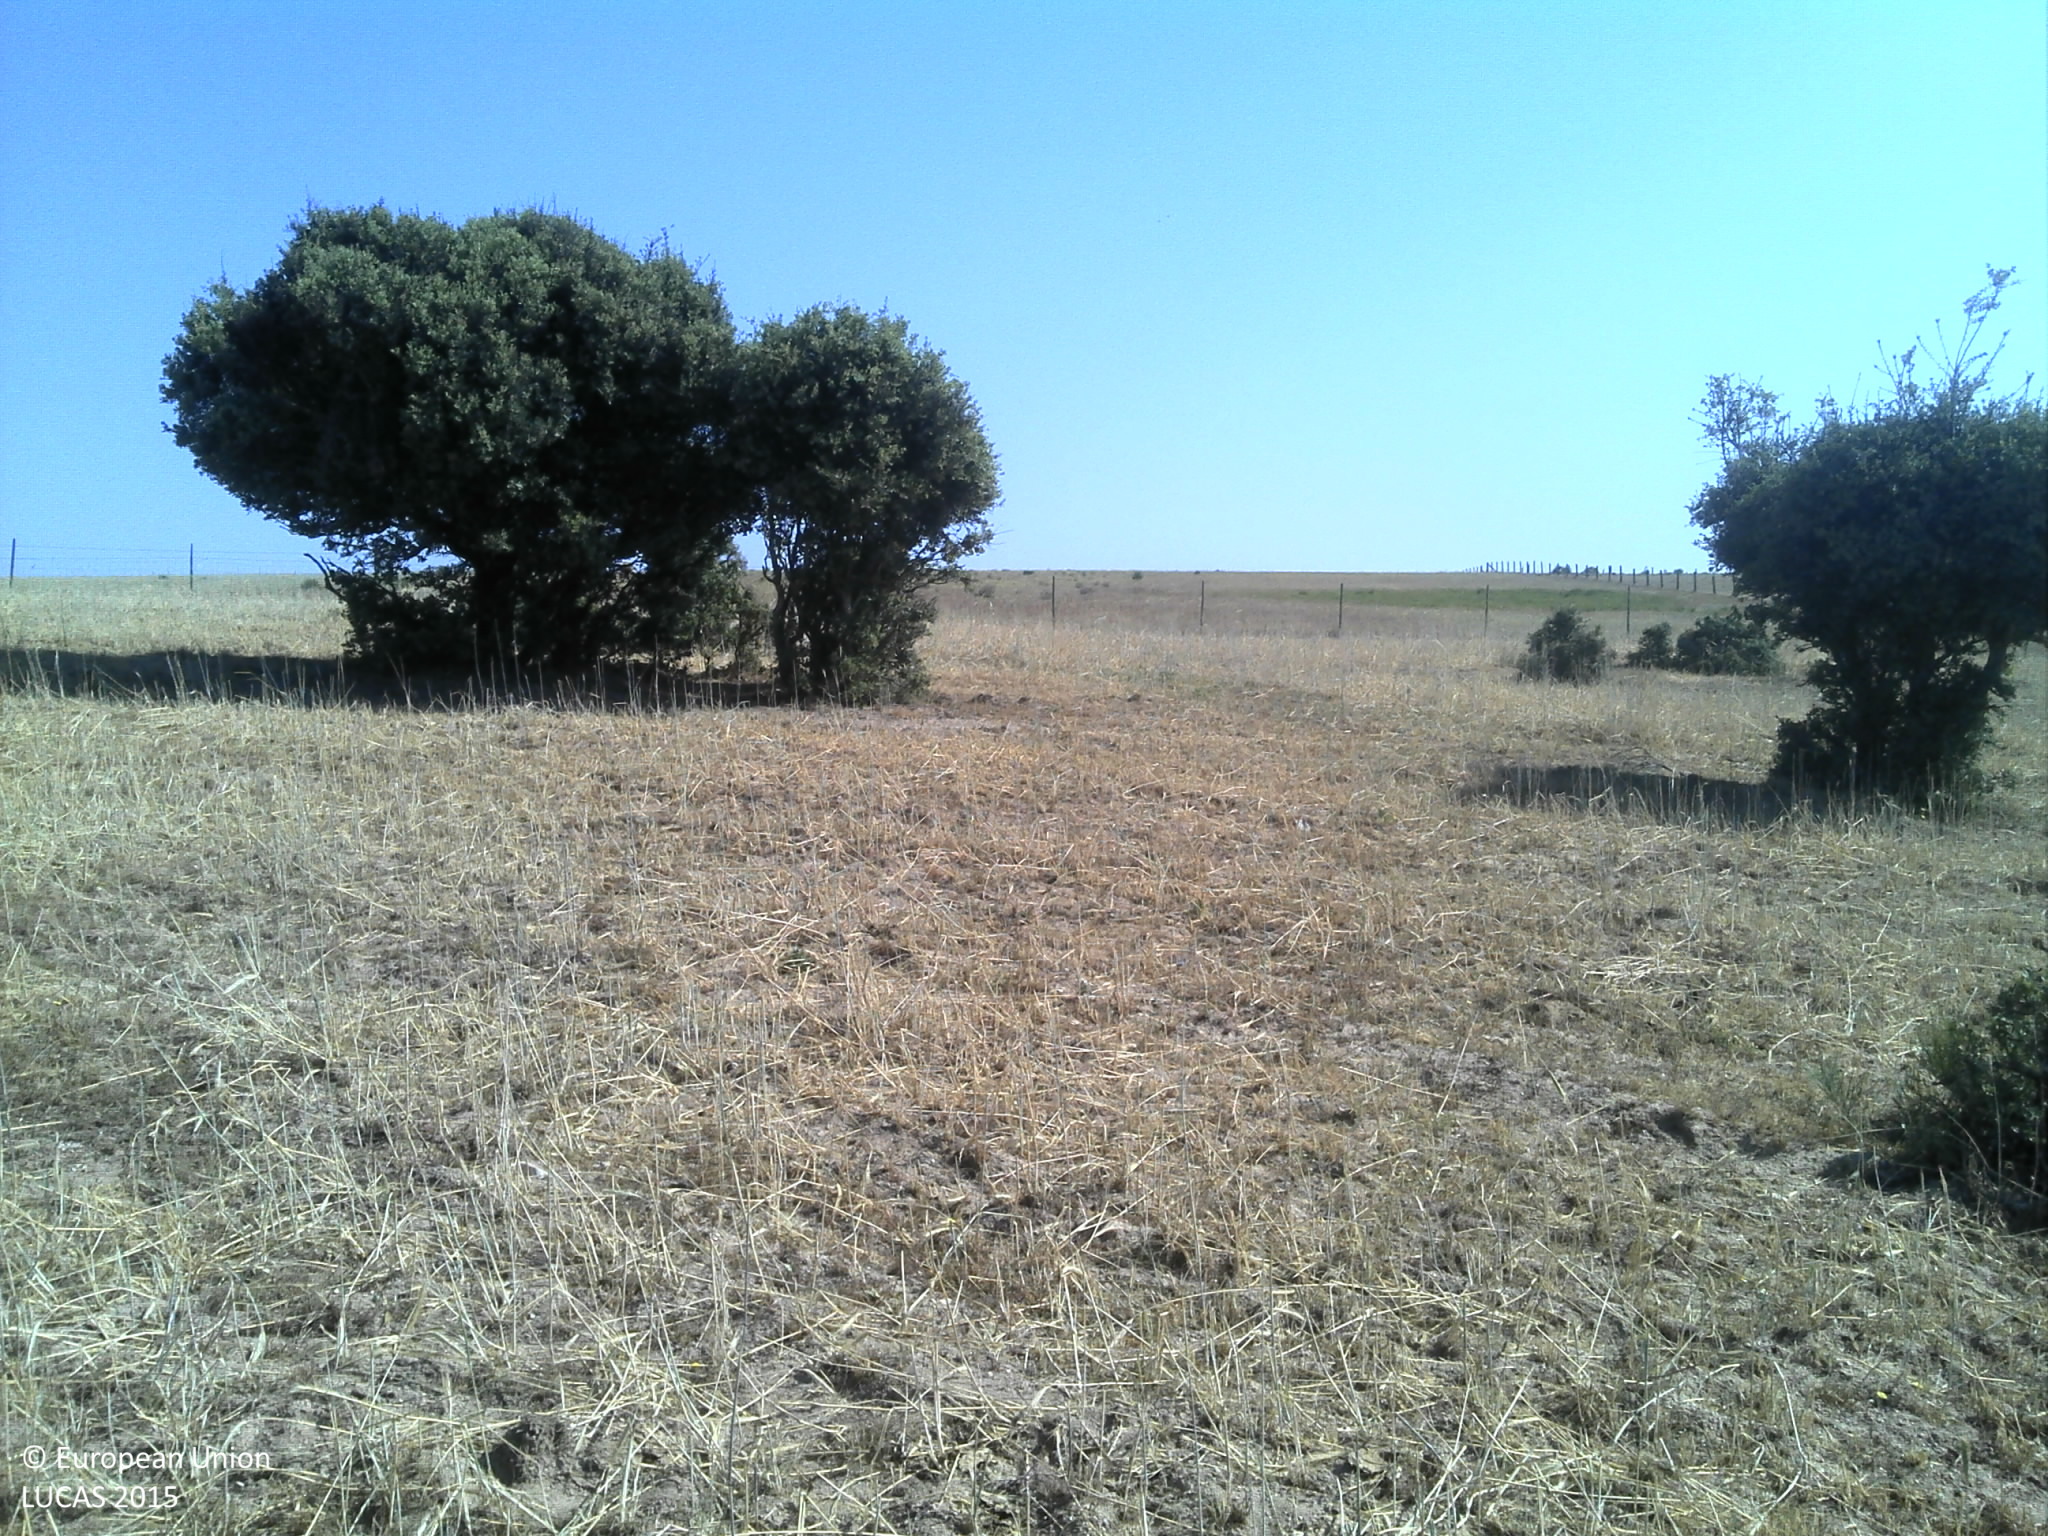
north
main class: Grassland
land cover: Grassland with sparse tree/shrub cover
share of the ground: 10 - 25 %
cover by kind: unconsolidated bare surface 85 %, herbaceous plants 10 %, broadleaved forest trees 5 %
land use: Agriculture (excluding fallow land and kitchen gardens)
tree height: > 5 m
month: June
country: PT
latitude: 40.5662
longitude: -6.8569
